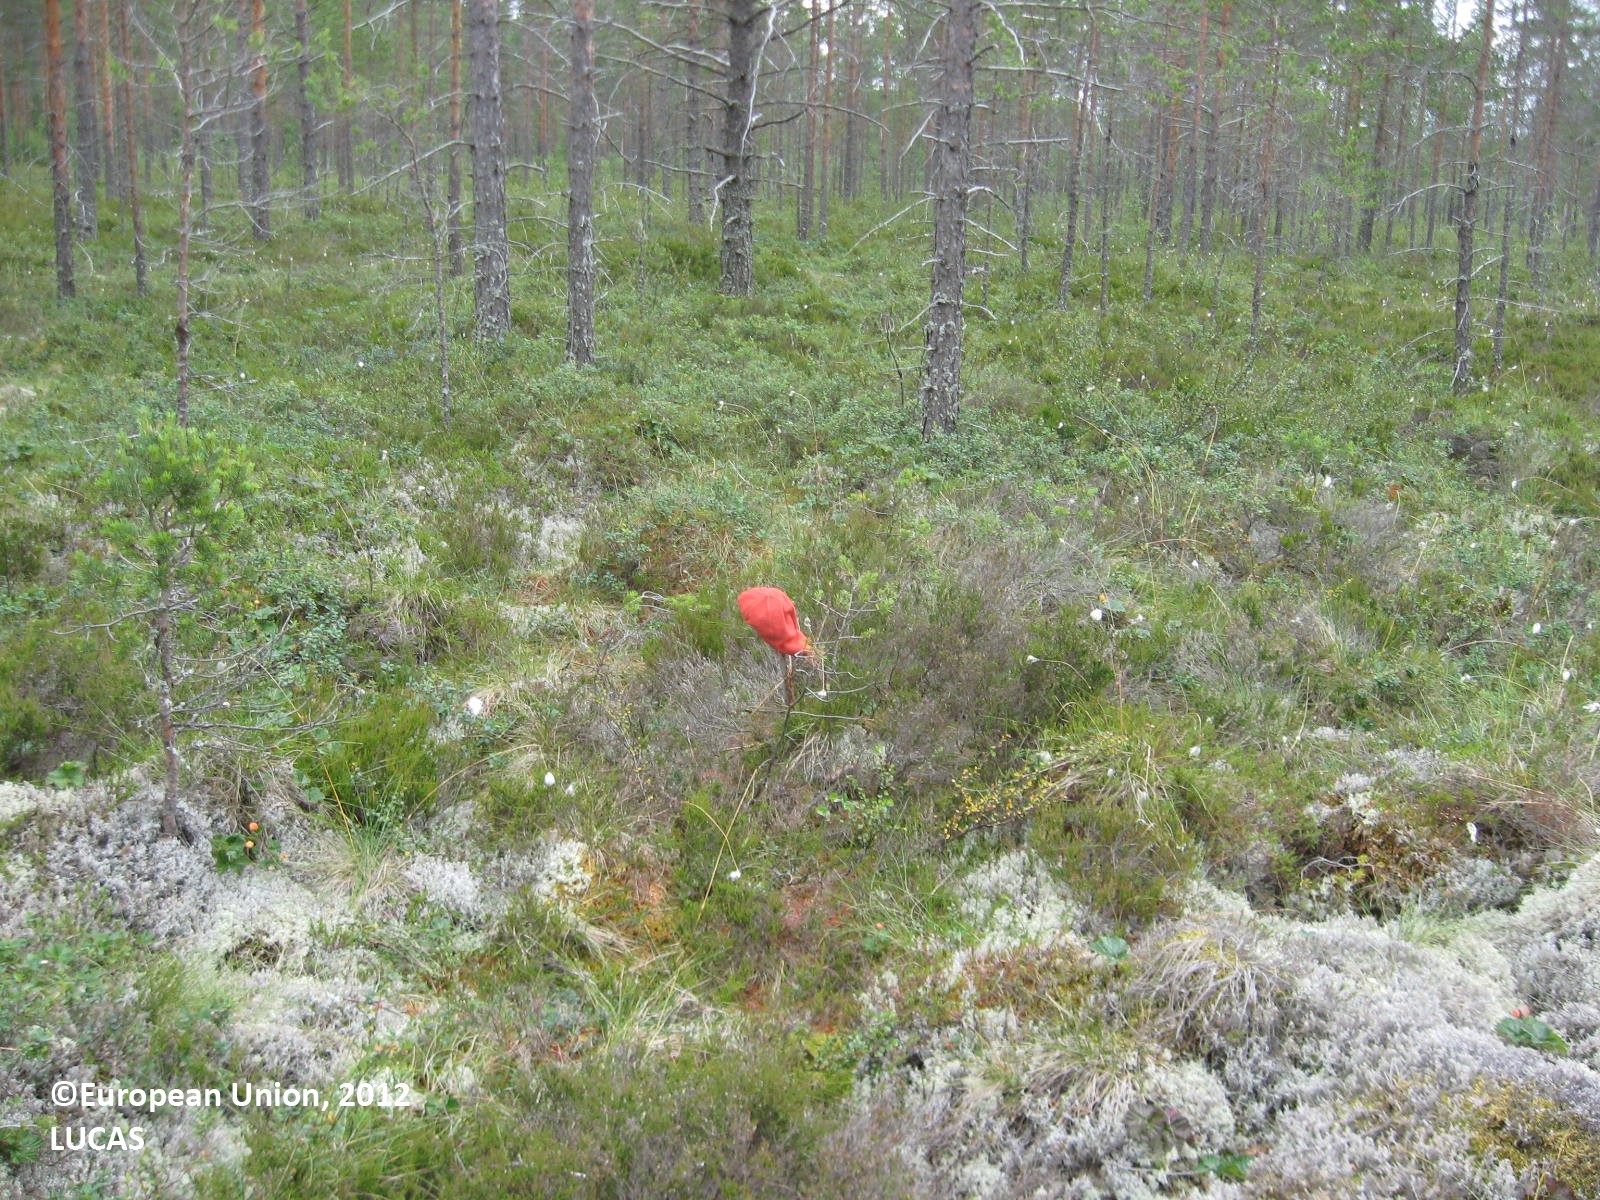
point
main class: Woodland
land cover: Pine dominated coniferous woodland
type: boreal forest
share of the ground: 50 - 75 %
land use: Forestry
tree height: > 5 m
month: July
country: FI
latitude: 62.1593
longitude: 22.7493
